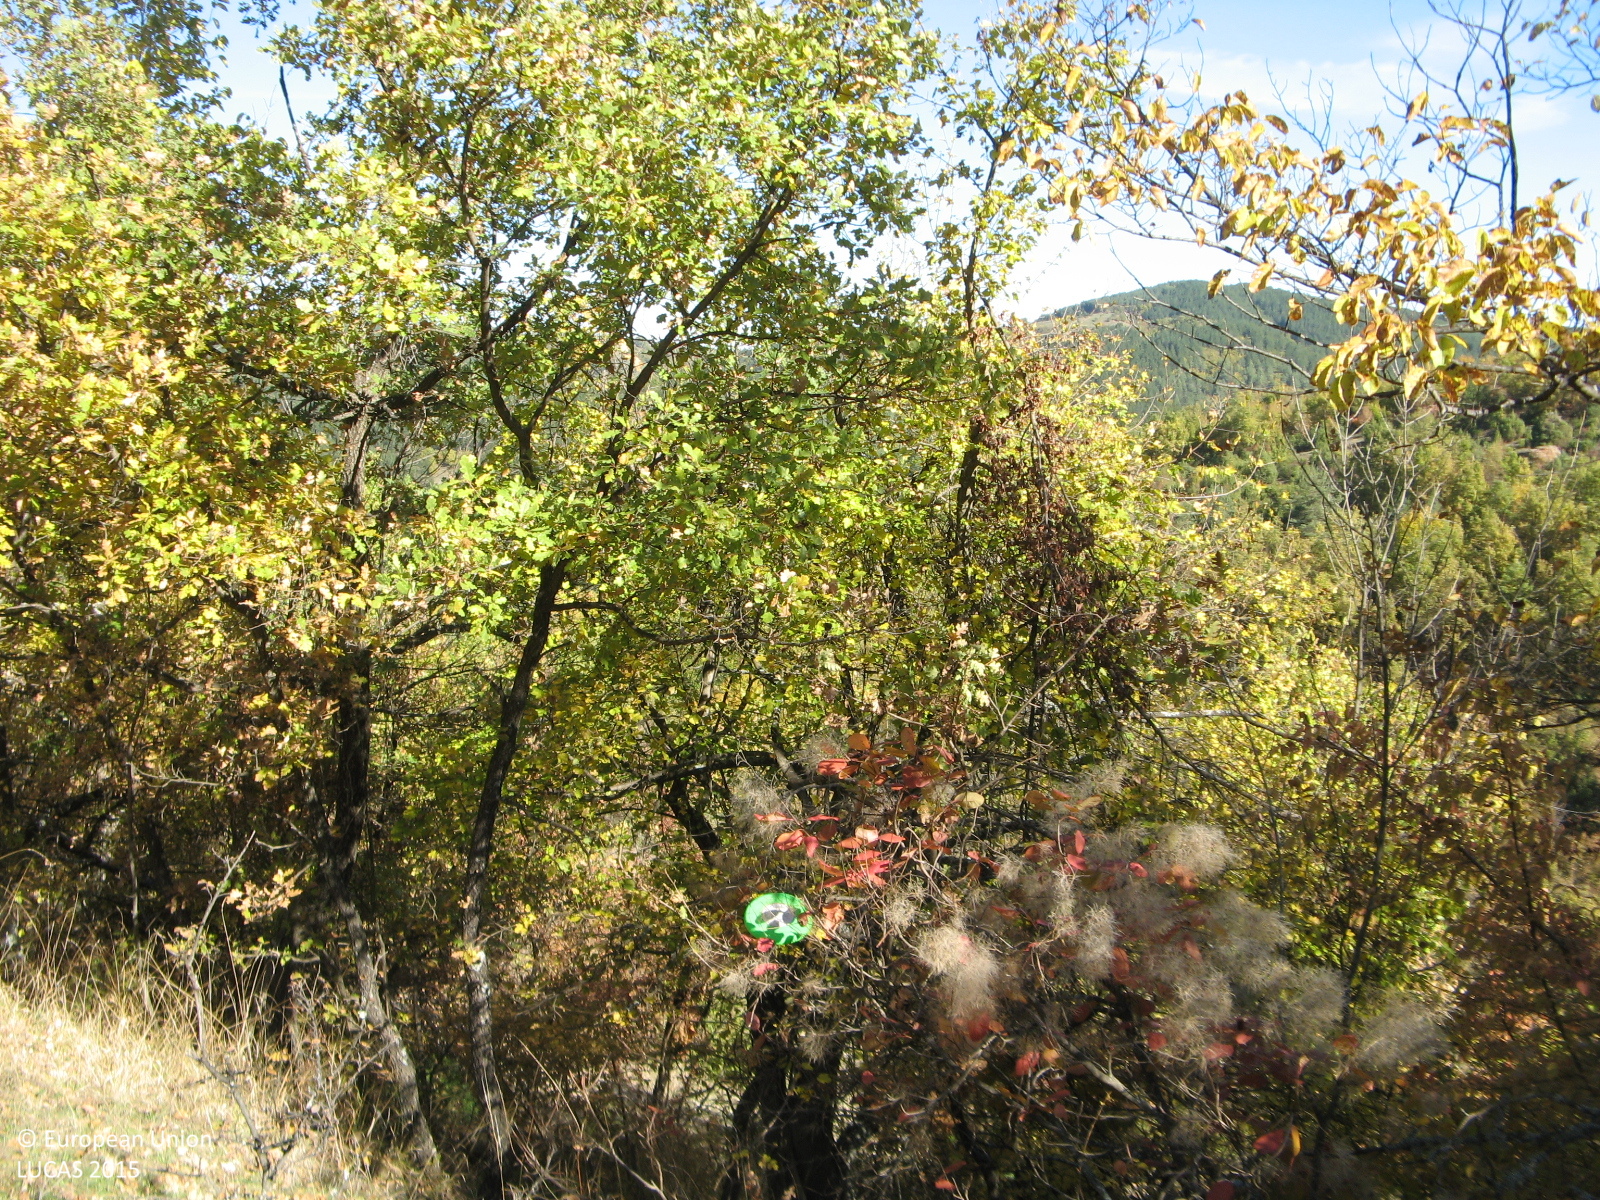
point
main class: Woodland
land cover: Broadleaved woodland
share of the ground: > 75 %
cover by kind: broadleaved forest trees 85 %, herbaceous plants 10 %, shrubs 5 %
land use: Agriculture (excluding fallow land and kitchen gardens)
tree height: < 5 m
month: November
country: BG
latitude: 41.5544
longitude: 25.3173
